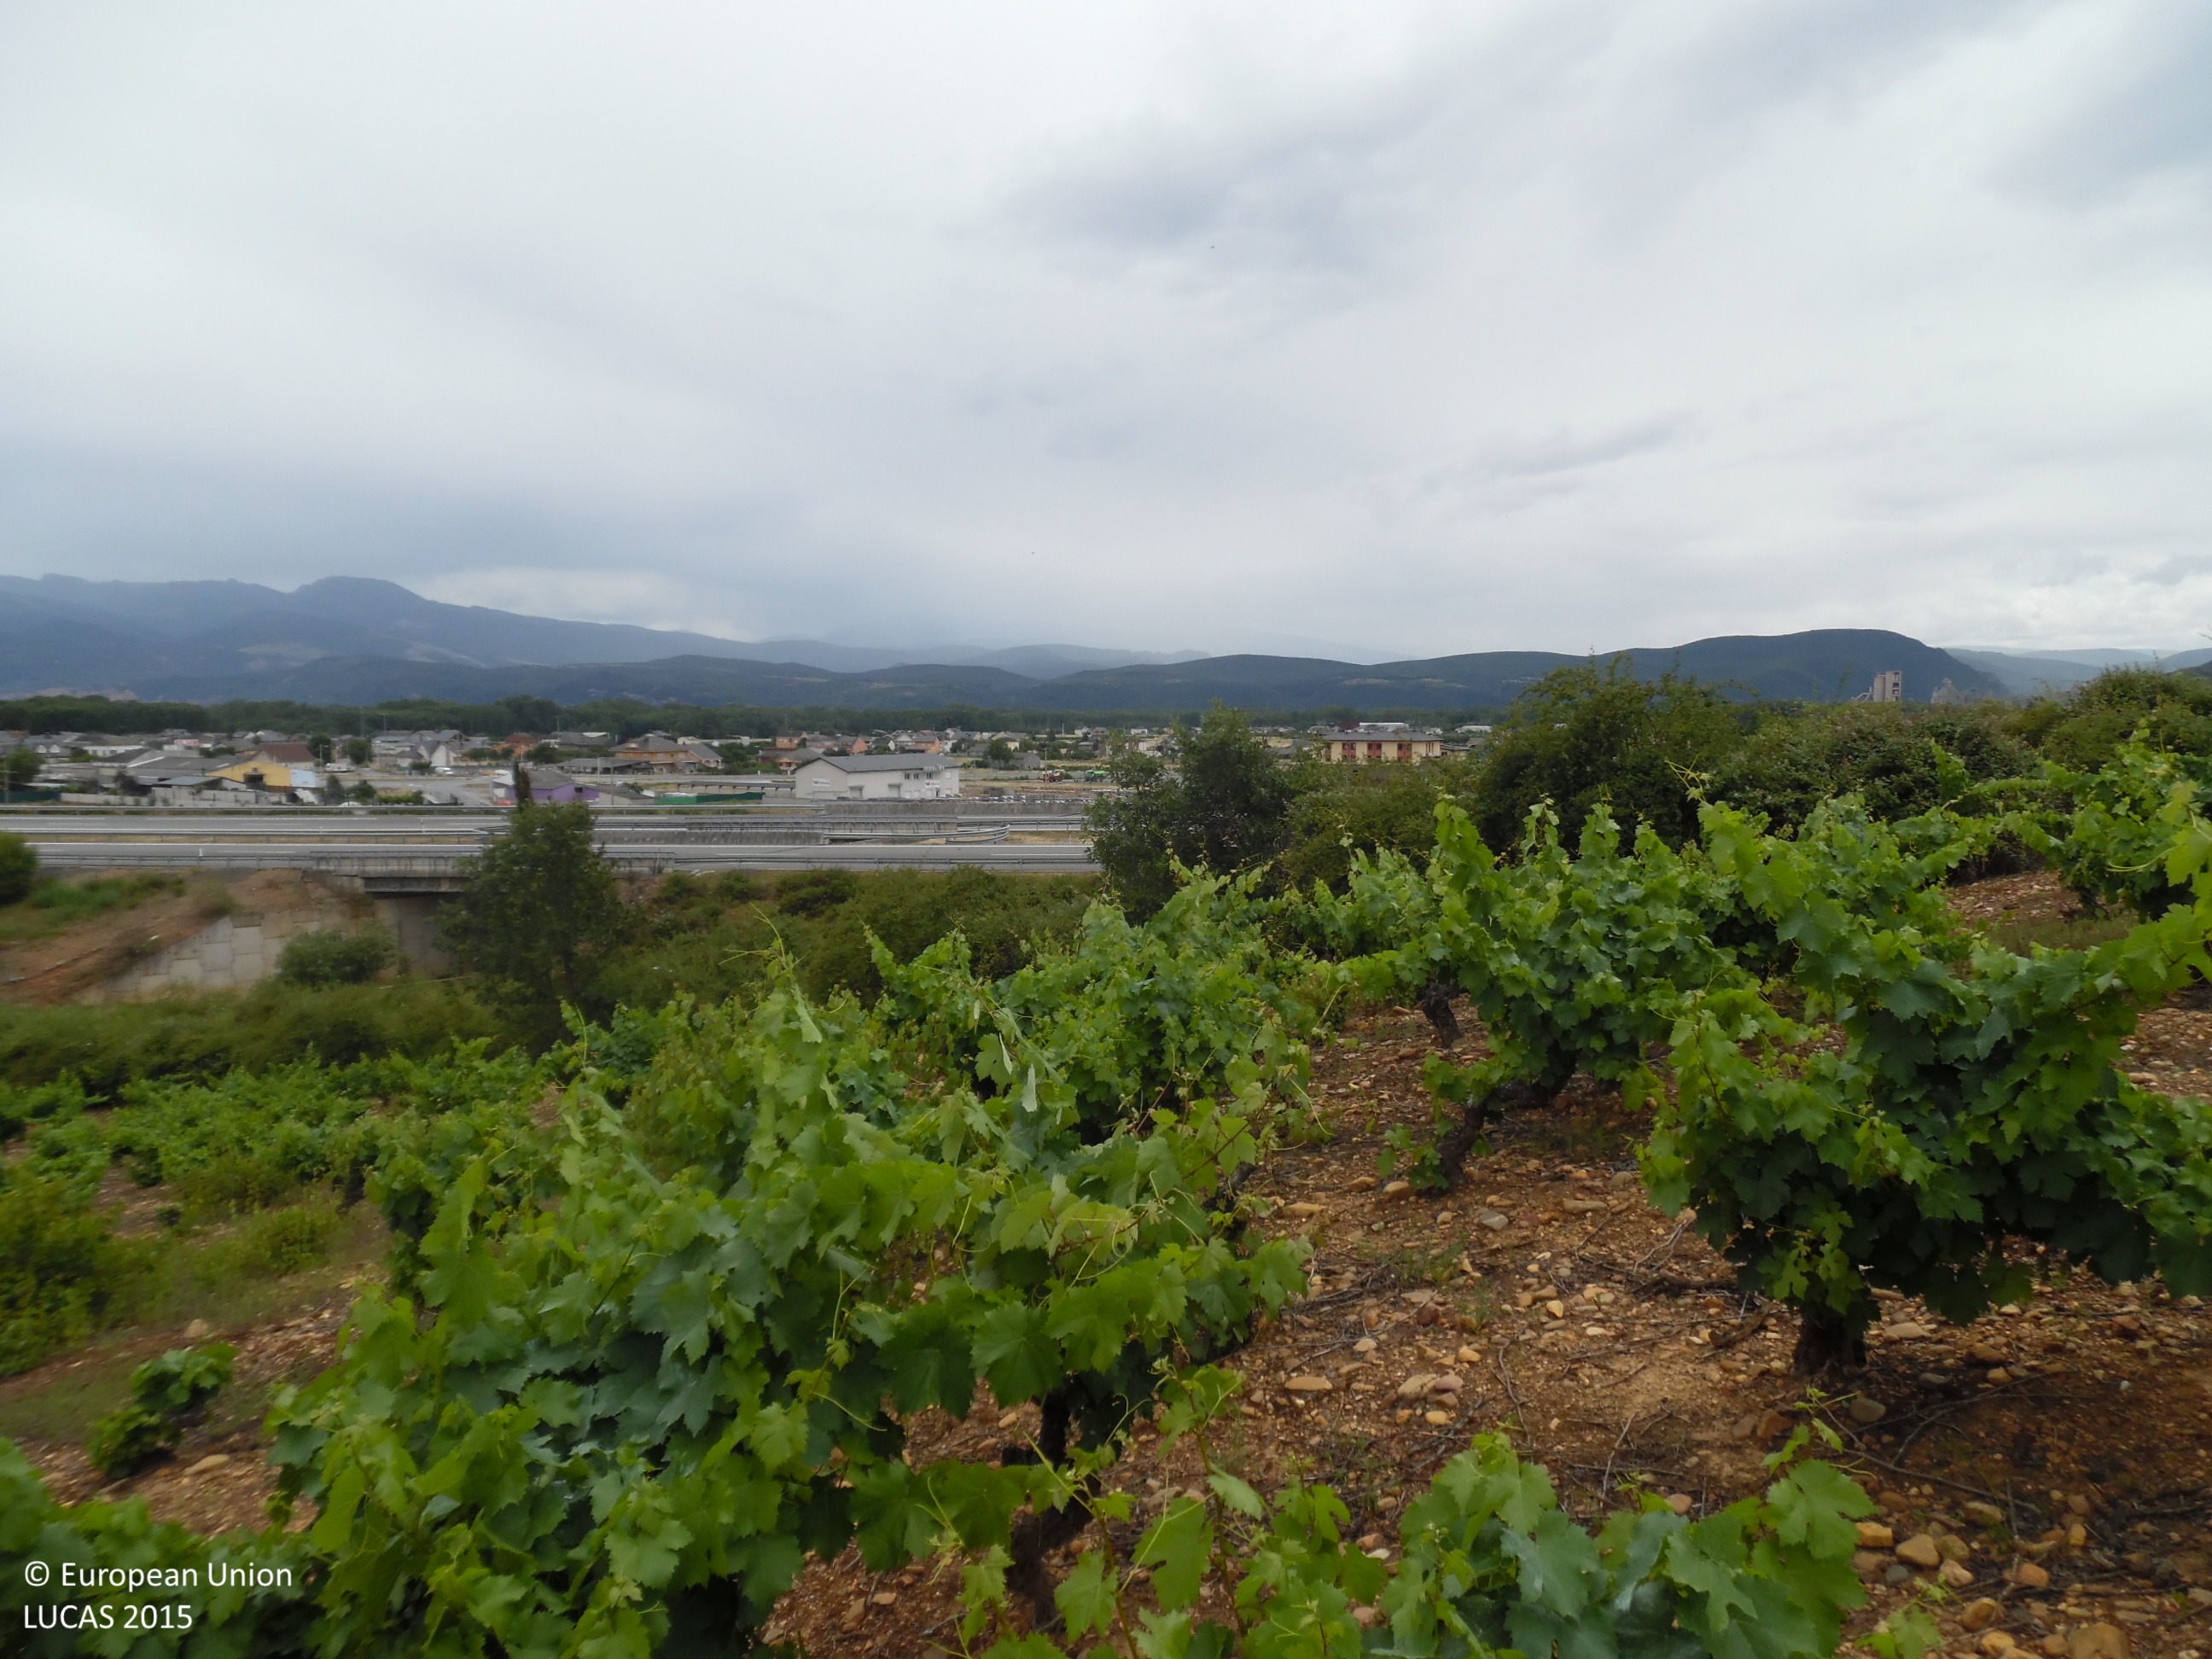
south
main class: Cropland
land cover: Vineyards
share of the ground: 50 - 75 %
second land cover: Other bare soil
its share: > 75 %
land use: Agriculture (excluding fallow land and kitchen gardens)
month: June
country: ES
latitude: 42.5720
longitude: -6.7529
